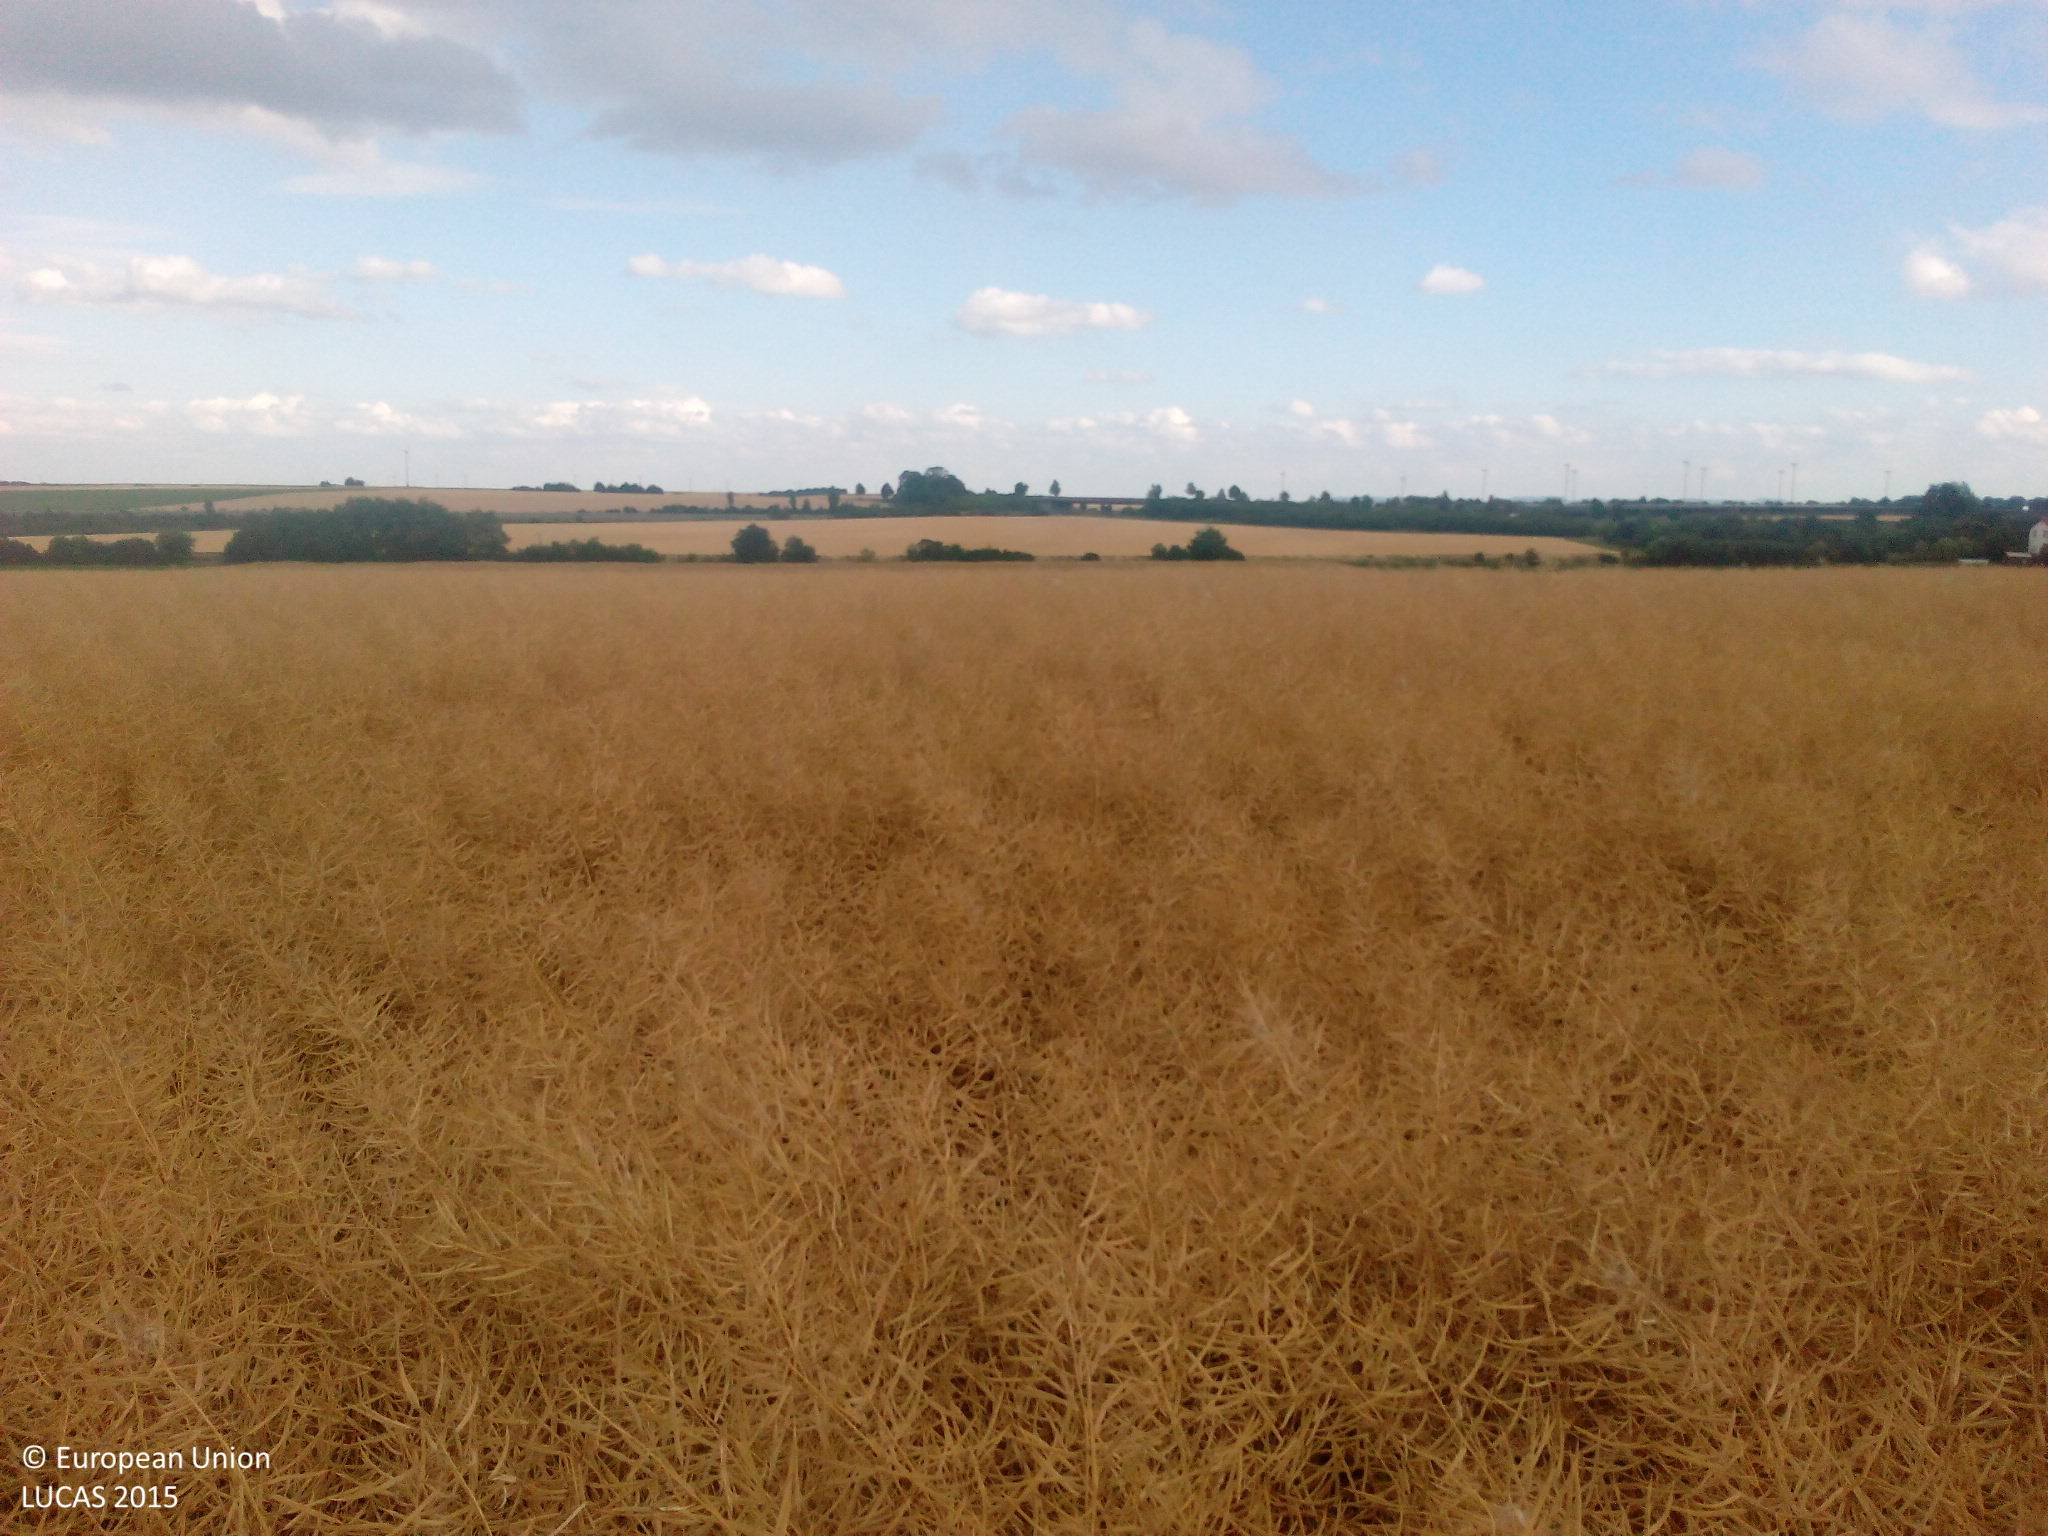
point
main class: Cropland
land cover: Rape and turnip rape
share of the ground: > 75 %
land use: Agriculture (excluding fallow land and kitchen gardens)
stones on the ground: < 10 %
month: July
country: DE
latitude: 49.6998
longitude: 8.0455
